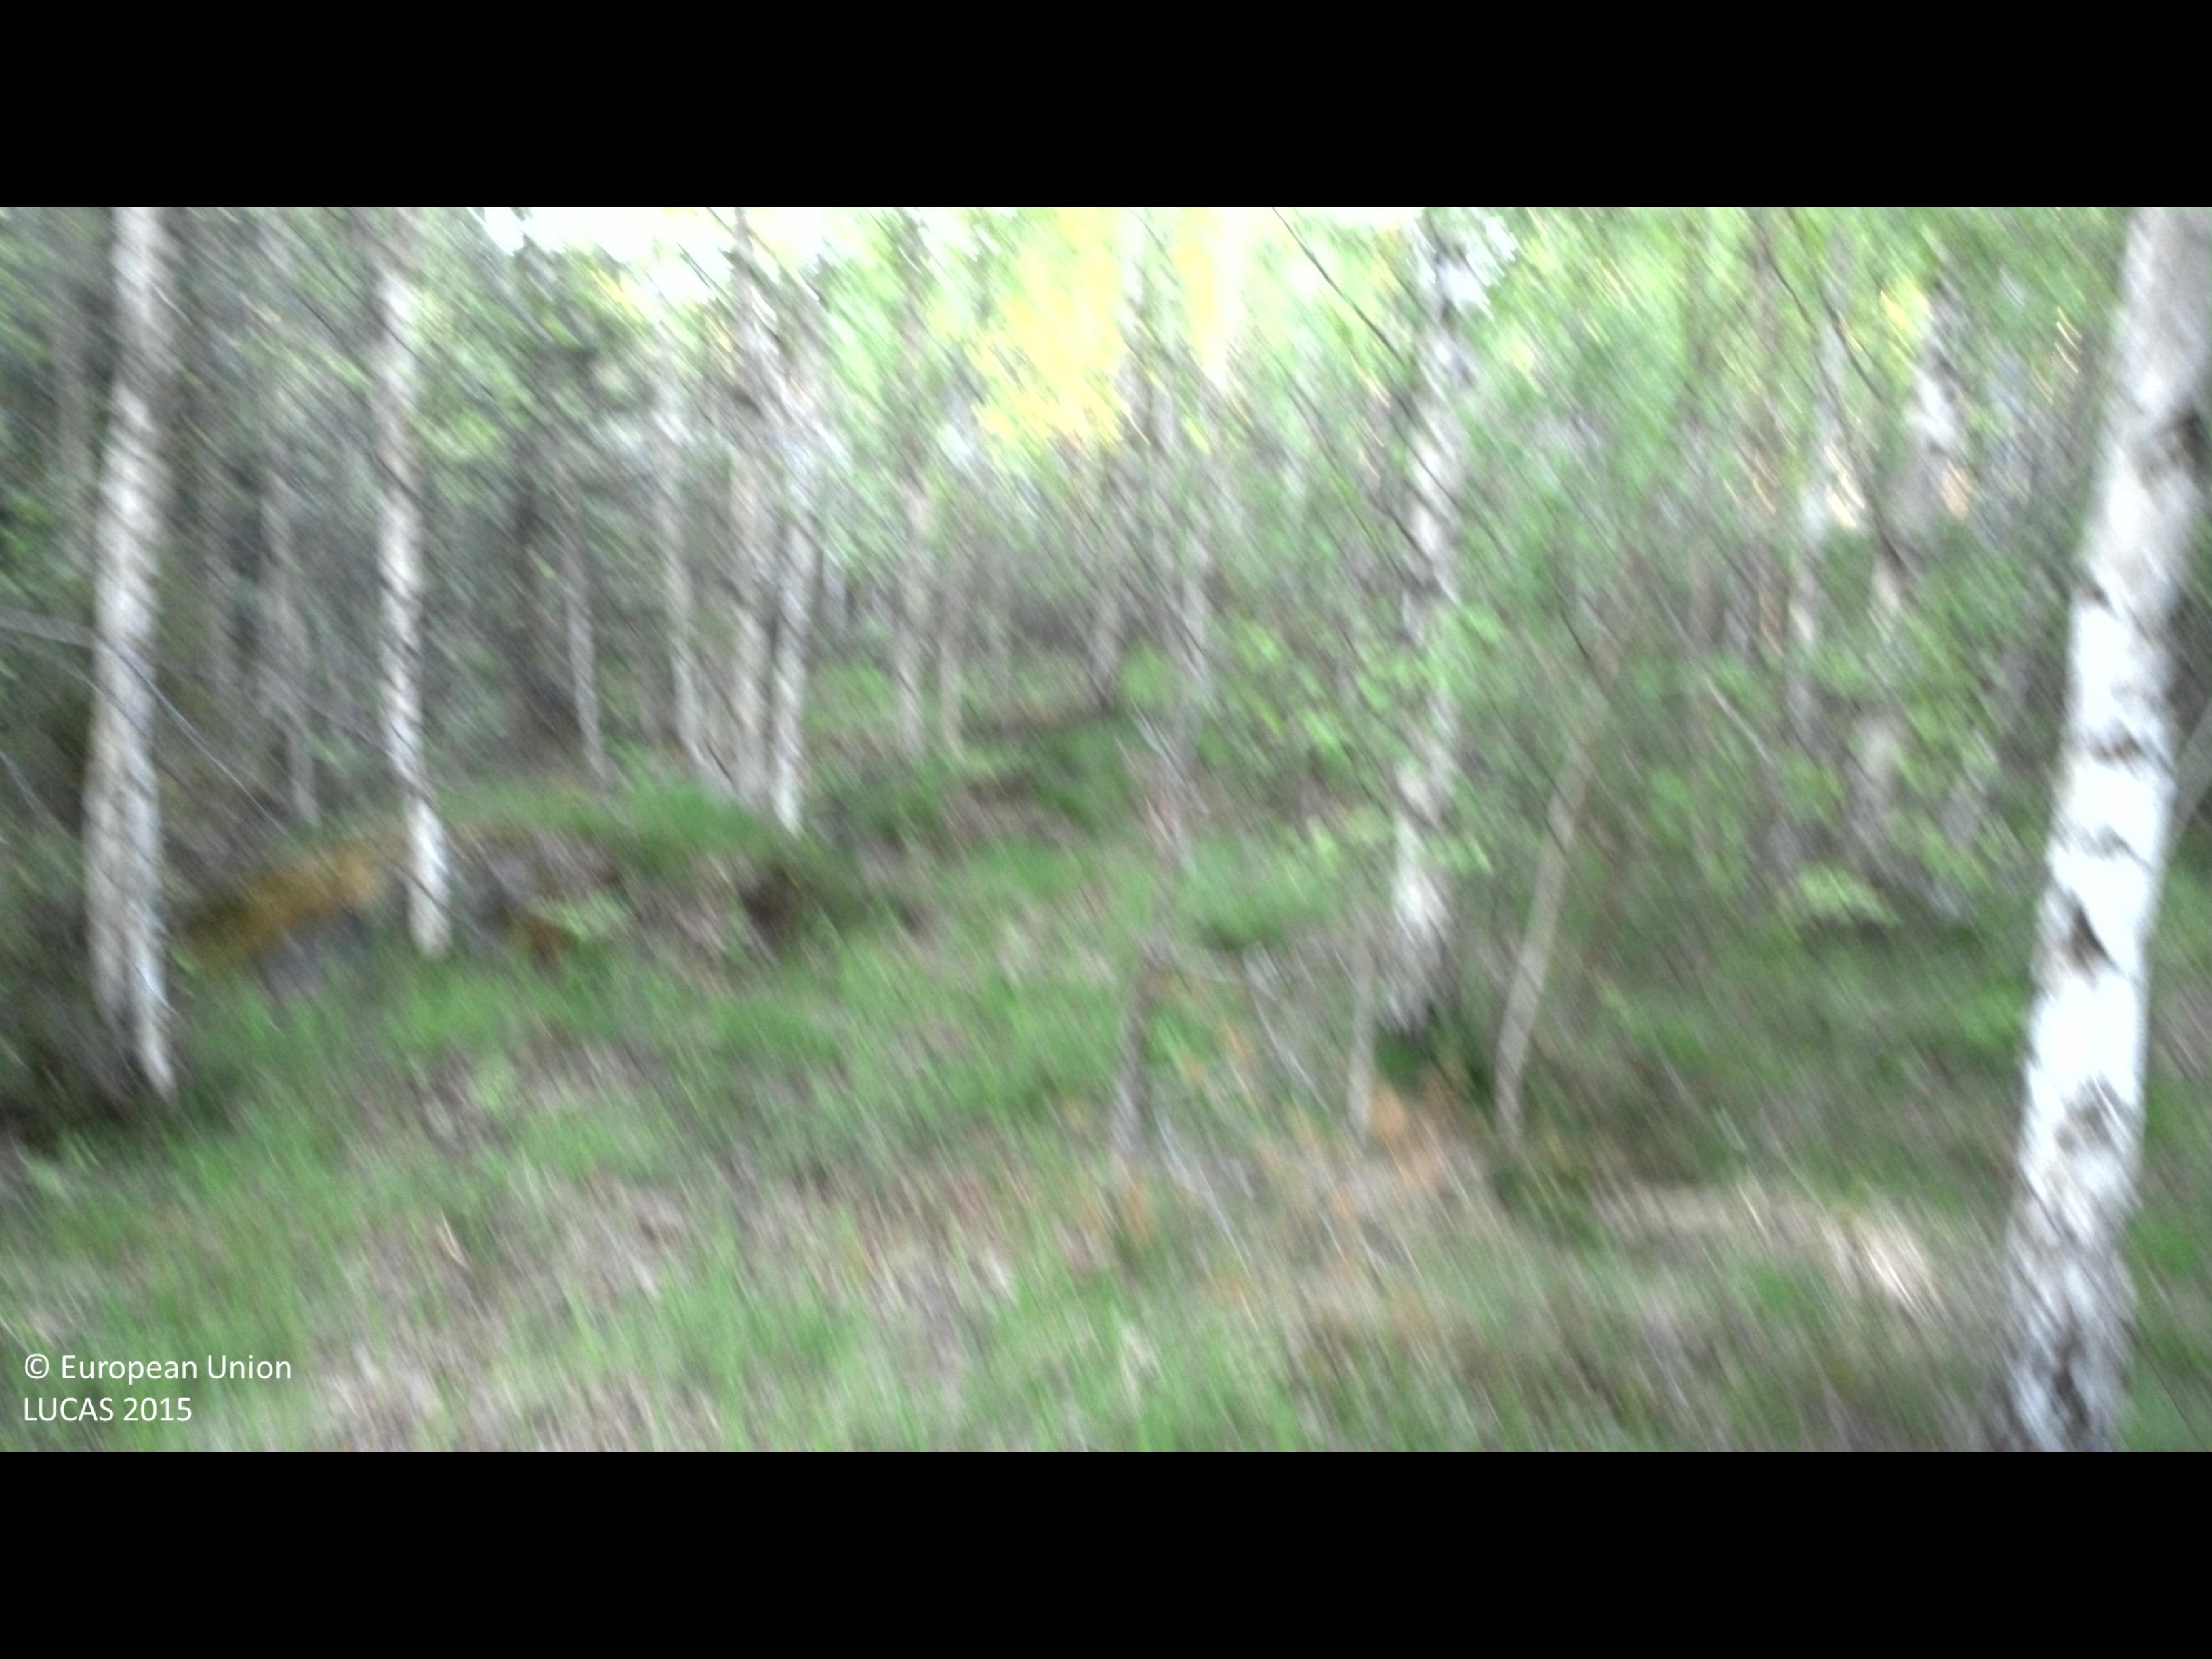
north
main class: Woodland
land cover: Broadleaved woodland
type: hemiboreal forest and nemoral coniferous forest and mixed broadleaved-coniferous forest
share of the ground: 50 - 75 %
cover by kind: broadleaved forest trees 70 %, herbaceous plants 15 %, shrubs 10 %, coniferous forest trees 5 %
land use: Forestry
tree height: > 5 m
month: May
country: SE
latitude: 57.3190
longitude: 16.1925
